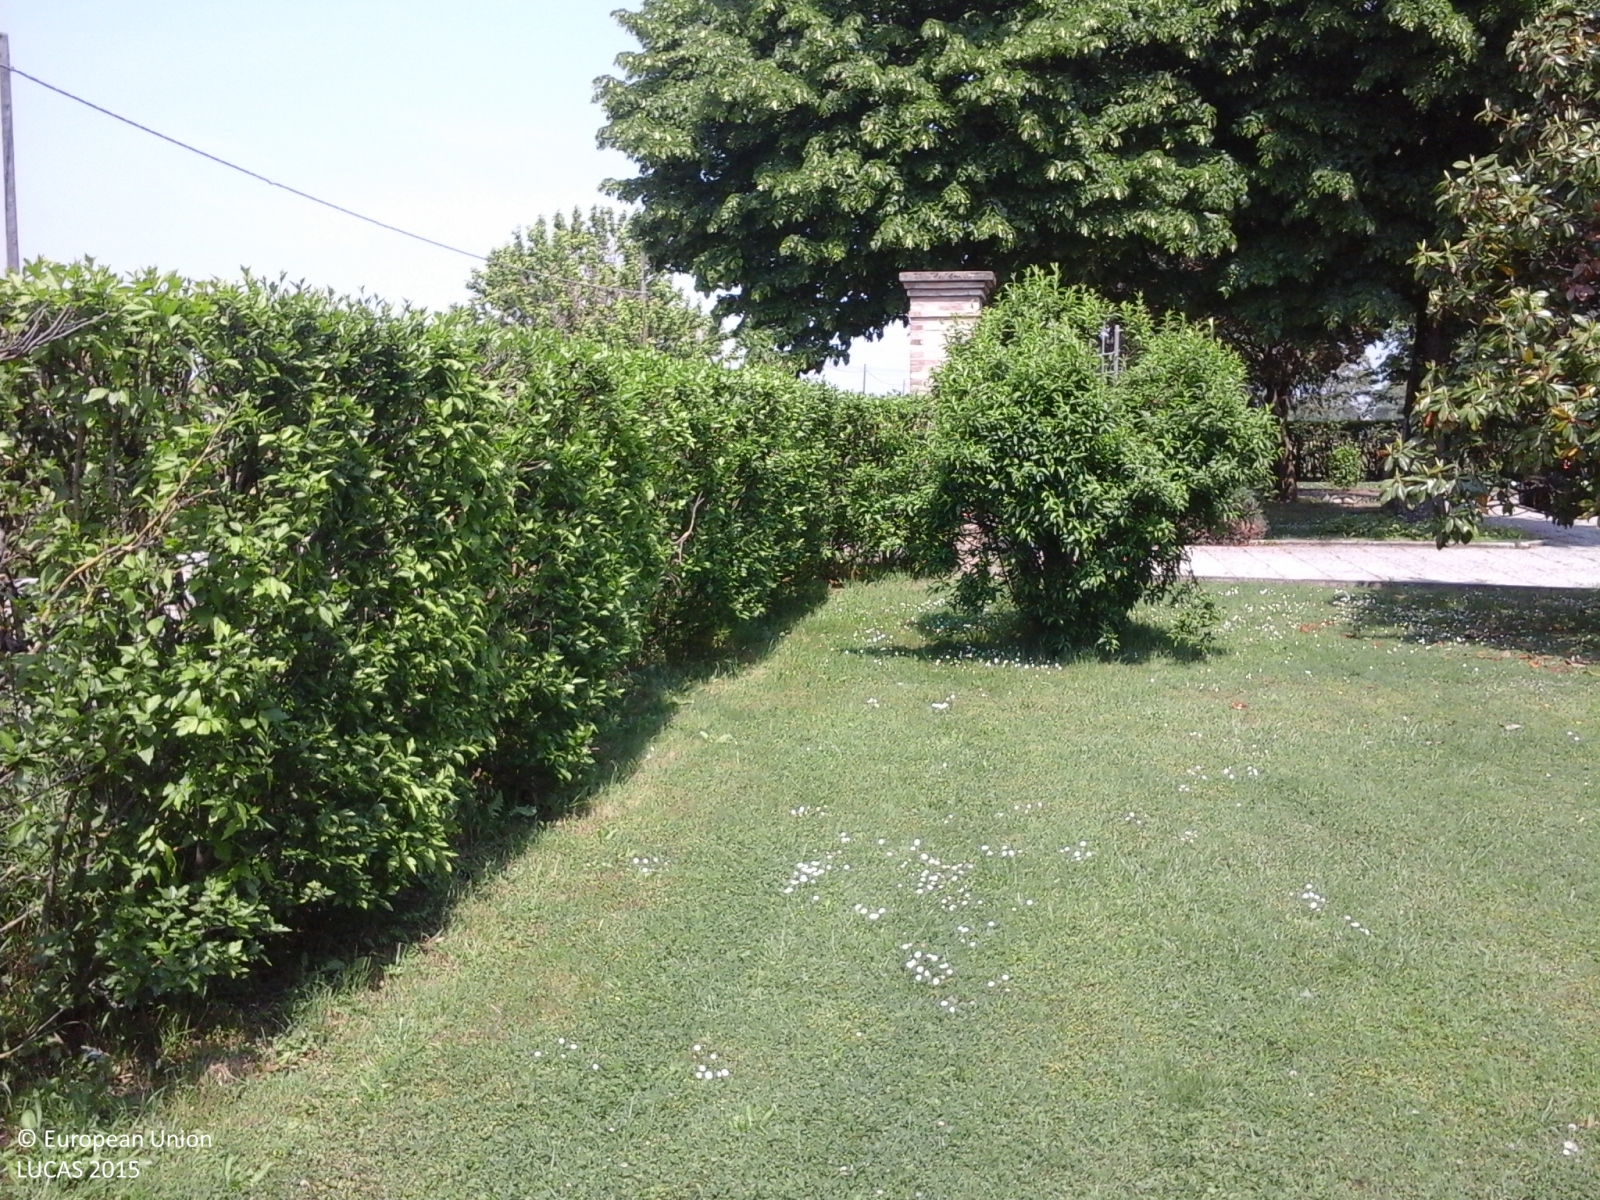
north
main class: Woodland
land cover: Broadleaved woodland
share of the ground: 10 - 25 %
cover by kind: herbaceous plants 90 %, broadleaved forest trees 10 %
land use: Residential
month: May
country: IT
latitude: 44.6365
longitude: 10.7422
